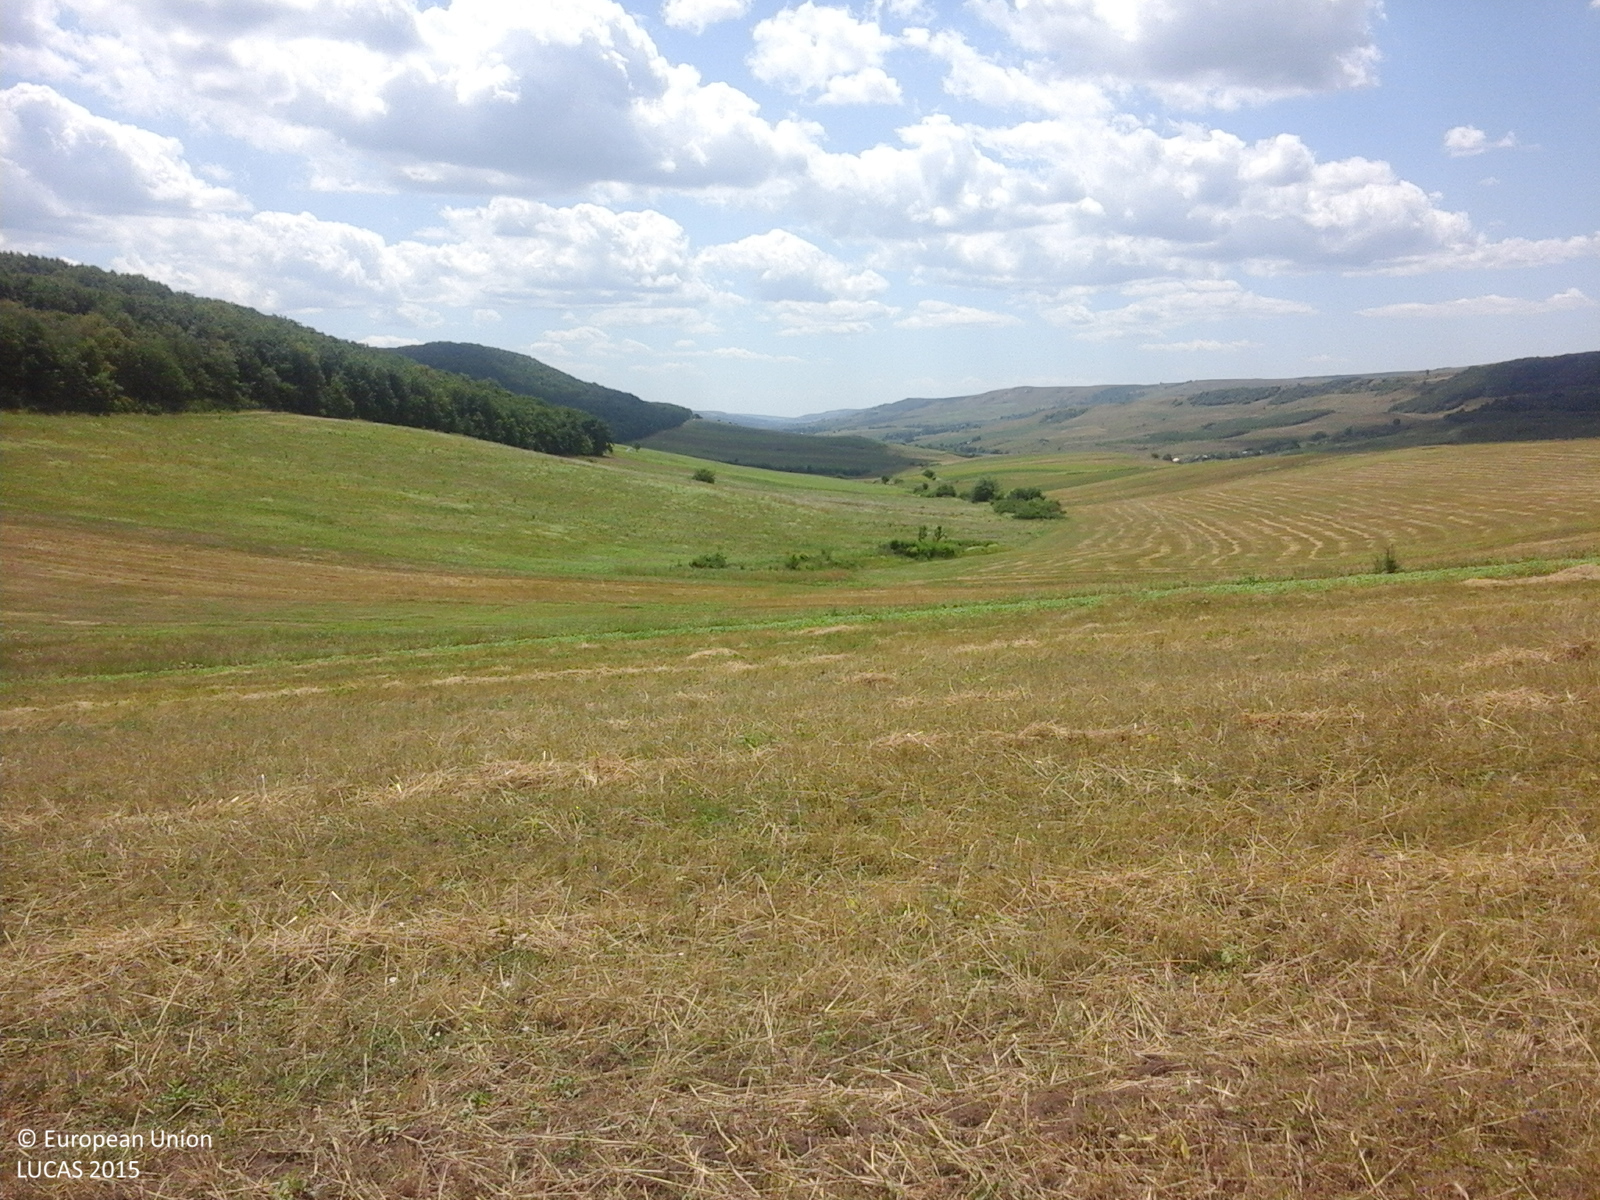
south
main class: Cropland
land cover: Common wheat
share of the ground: > 75 %
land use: Agriculture (excluding fallow land and kitchen gardens)
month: July
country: RO
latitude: 46.4205
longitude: 27.3991
